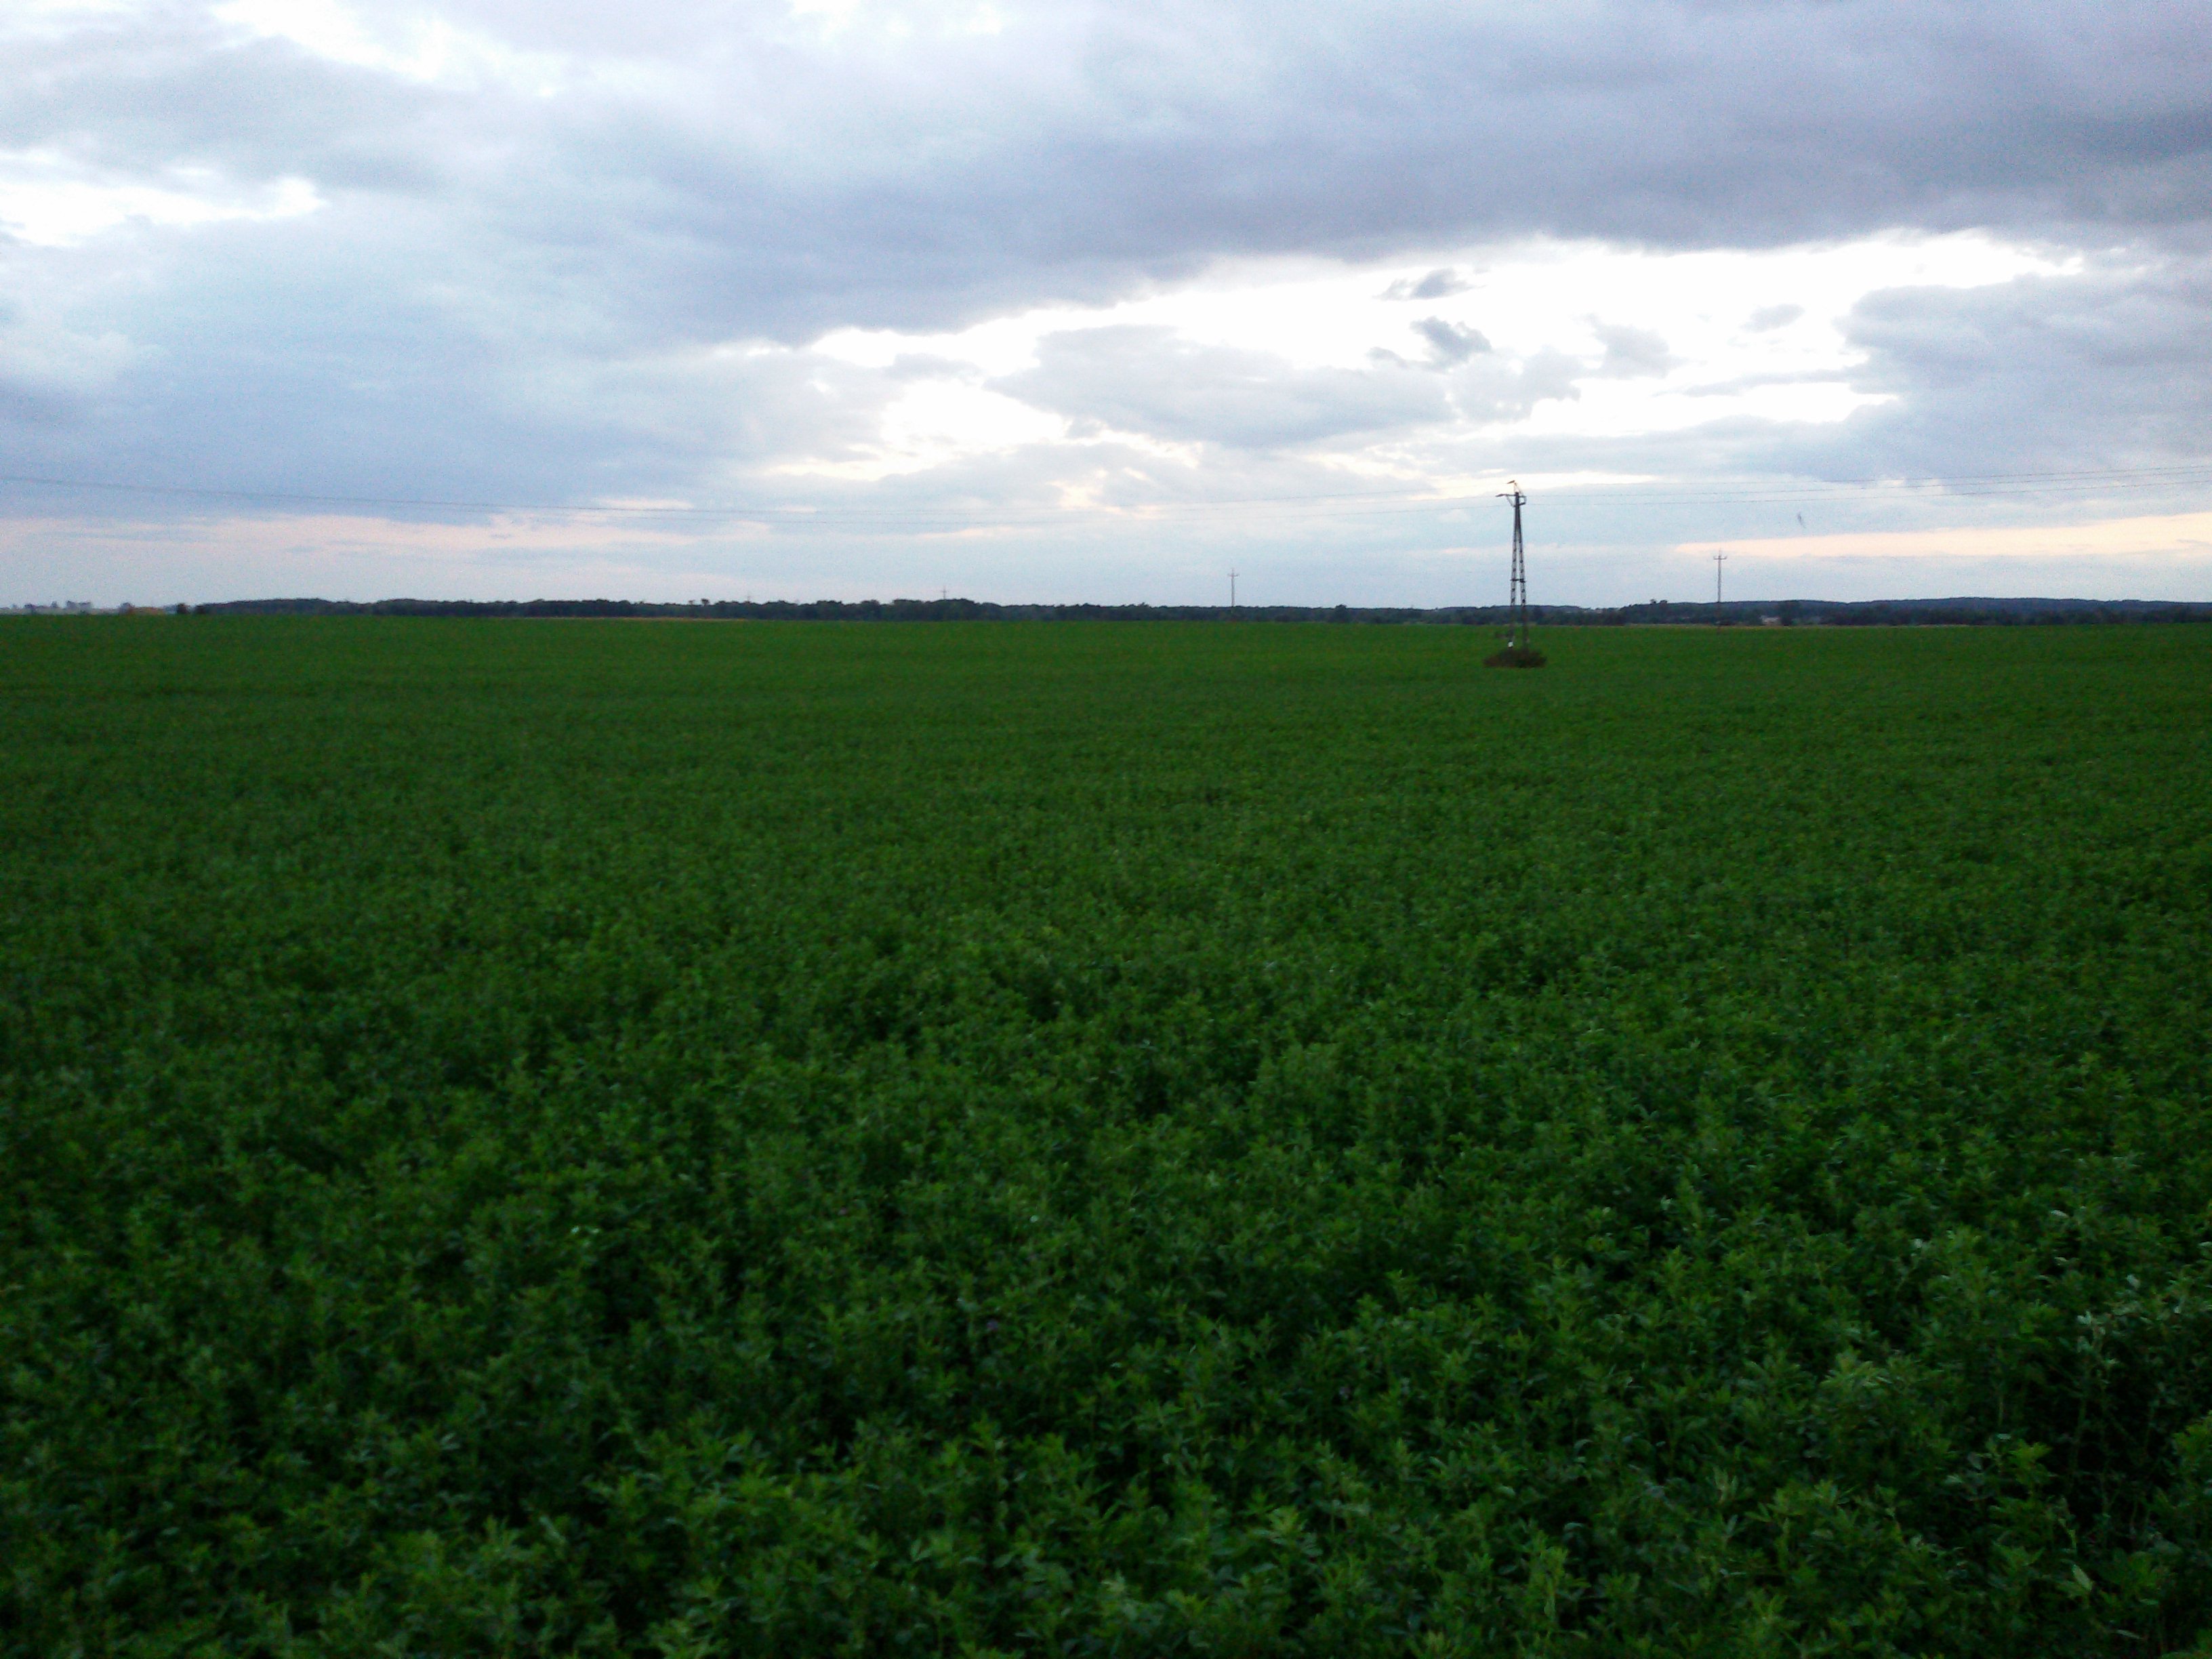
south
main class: Cropland
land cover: Lucerne
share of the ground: > 75 %
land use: Agriculture (excluding fallow land and kitchen gardens)
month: September
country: PL
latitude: 53.0147
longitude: 17.6597
